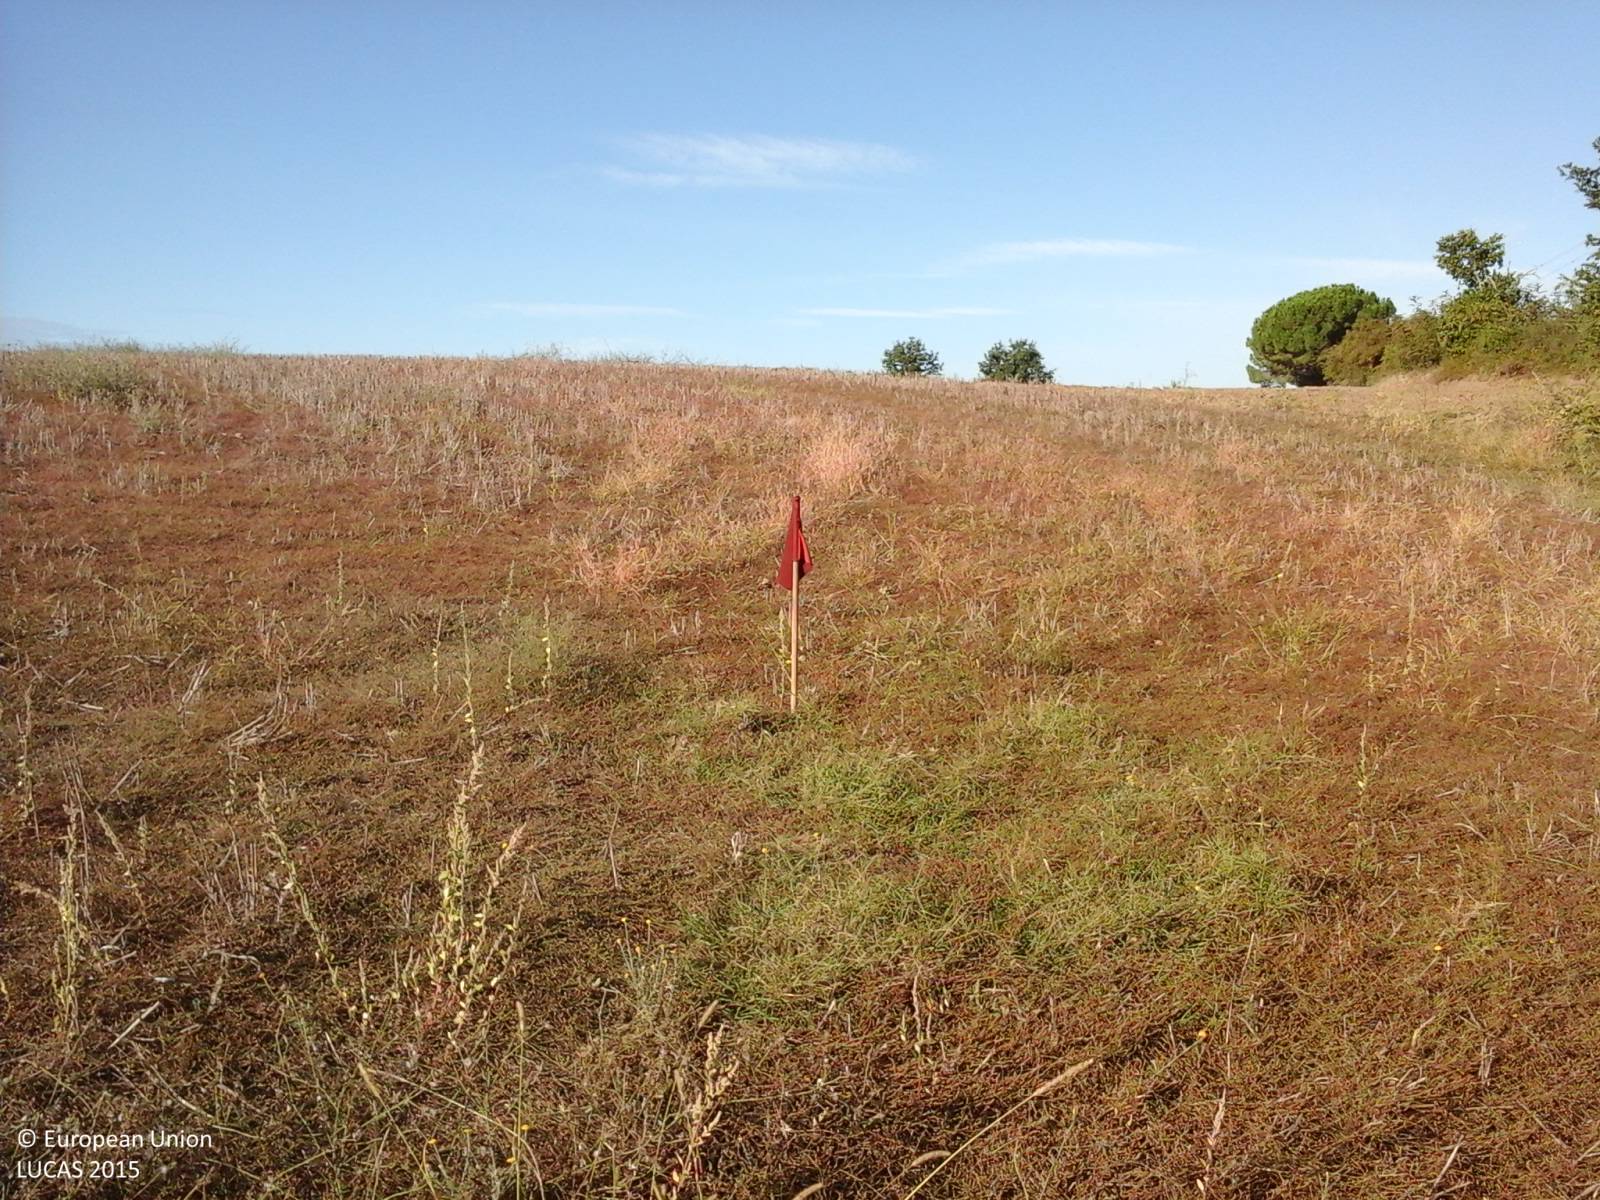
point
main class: Cropland
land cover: Durum wheat
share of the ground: < 10 %
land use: Agriculture (excluding fallow land and kitchen gardens)
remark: Harvested field
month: September
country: IT
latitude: 42.5574
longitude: 12.2216
